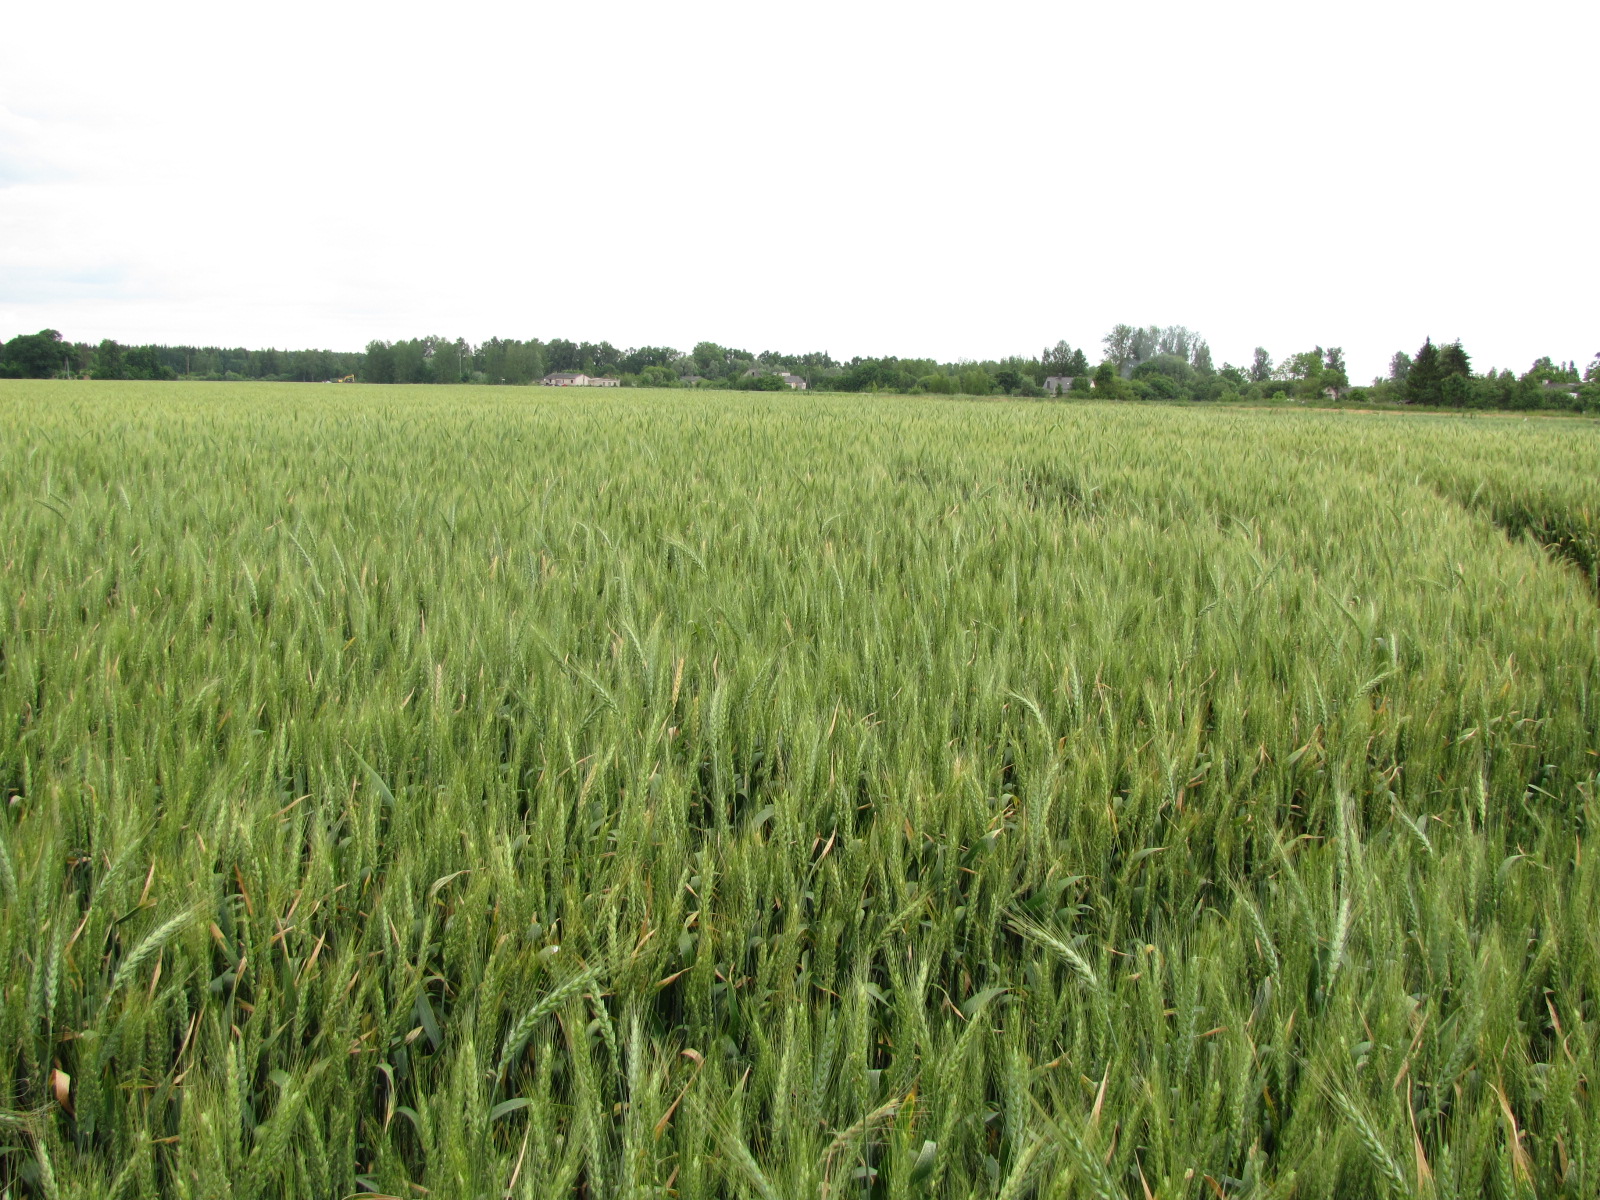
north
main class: Cropland
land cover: Triticale
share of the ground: > 75 %
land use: Agriculture (excluding fallow land and kitchen gardens)
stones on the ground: < 10 %
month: June
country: LV
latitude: 56.4229
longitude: 23.9791
